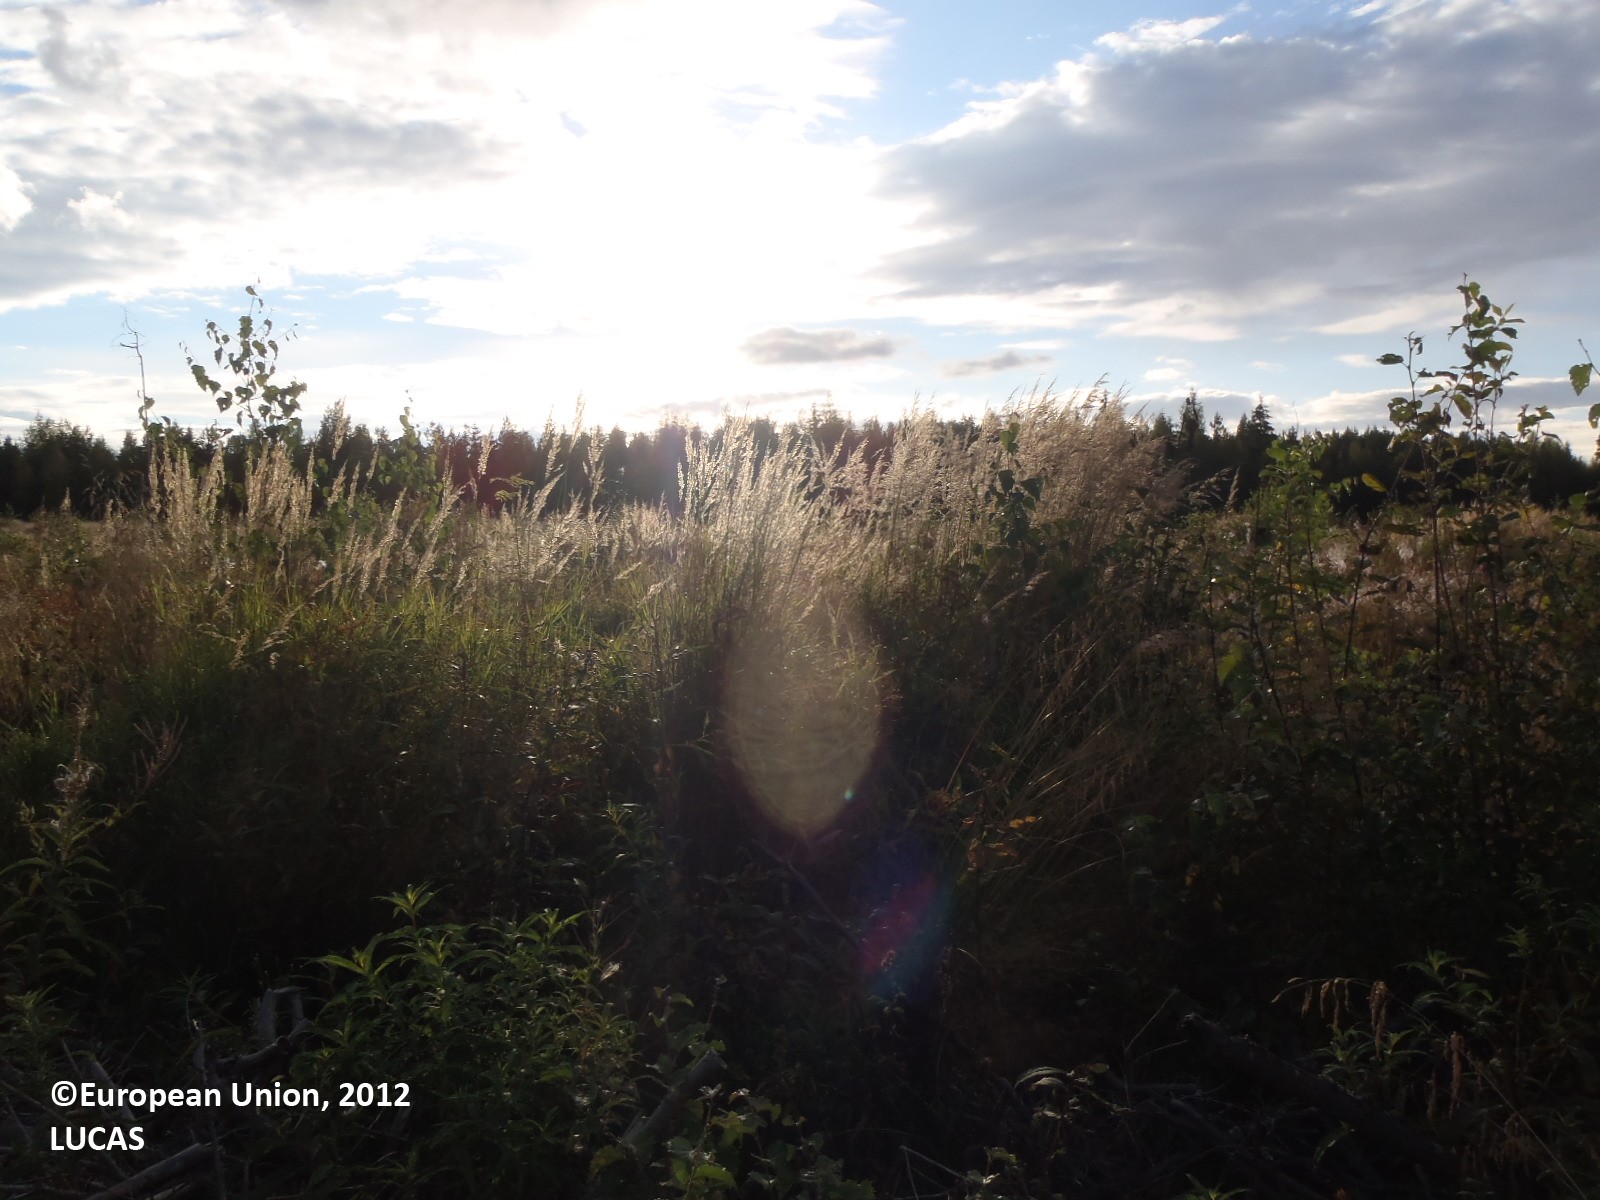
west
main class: Woodland
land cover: Broadleaved woodland
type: boreal forest
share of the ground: 10 - 25 %
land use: Forestry
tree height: < 5 m
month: August
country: FI
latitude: 60.6137
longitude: 22.4370
